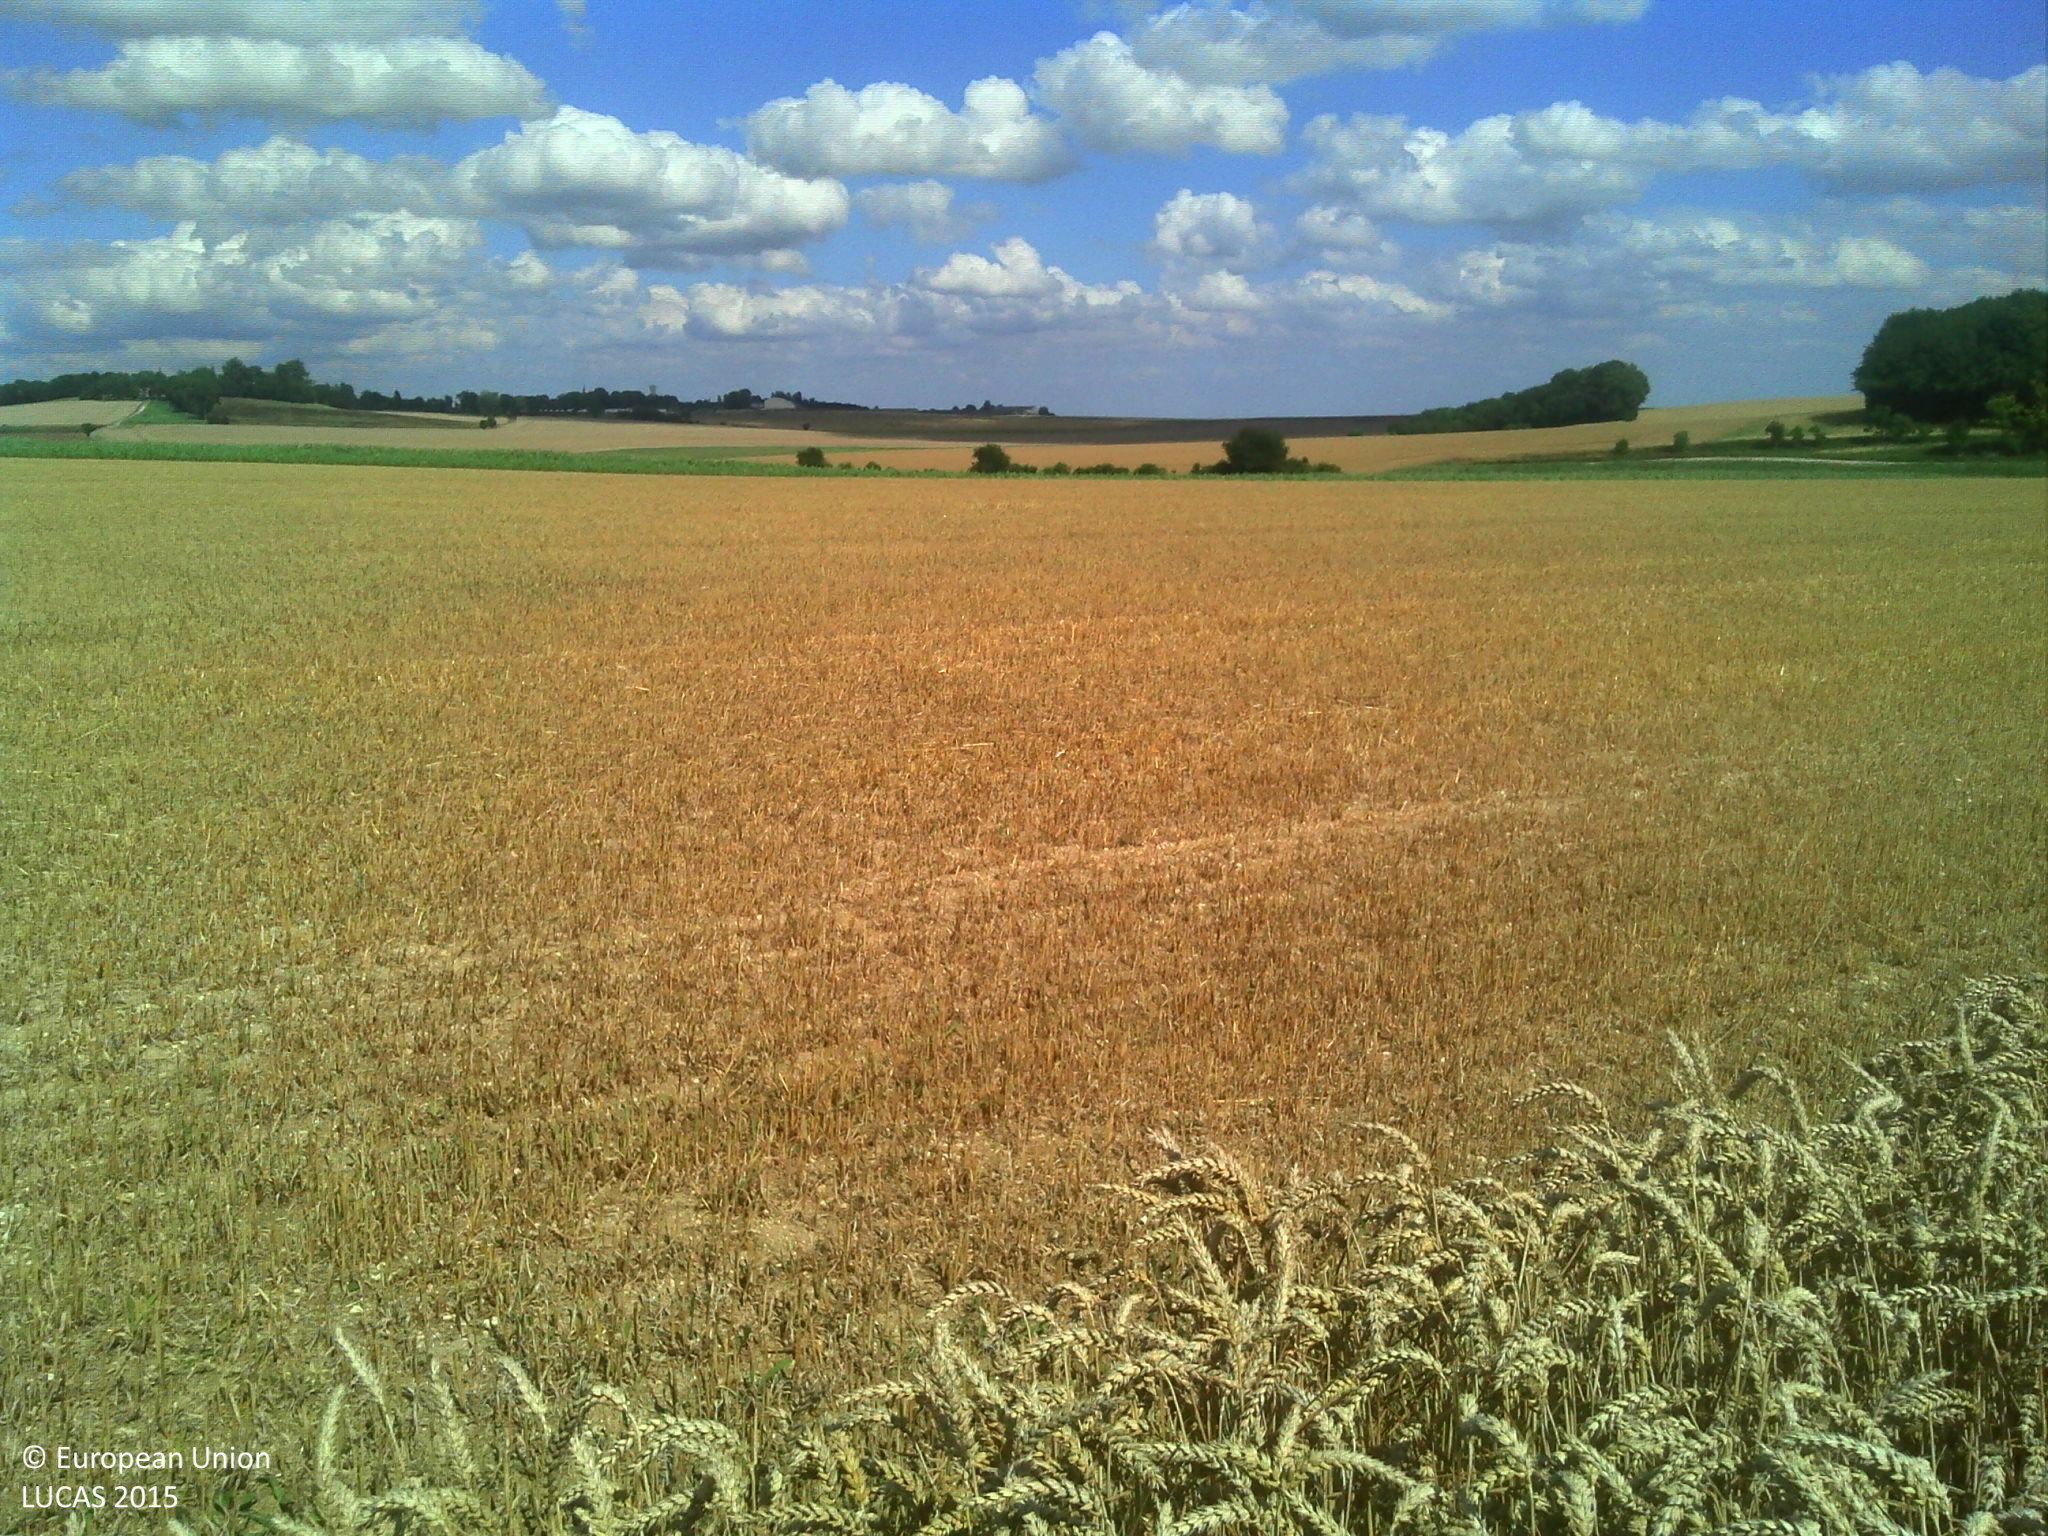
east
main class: Cropland
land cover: Common wheat
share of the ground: > 75 %
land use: Agriculture (excluding fallow land and kitchen gardens)
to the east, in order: Common wheat; Barley; Maize
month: July
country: FR
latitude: 49.7547
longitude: 3.6499
